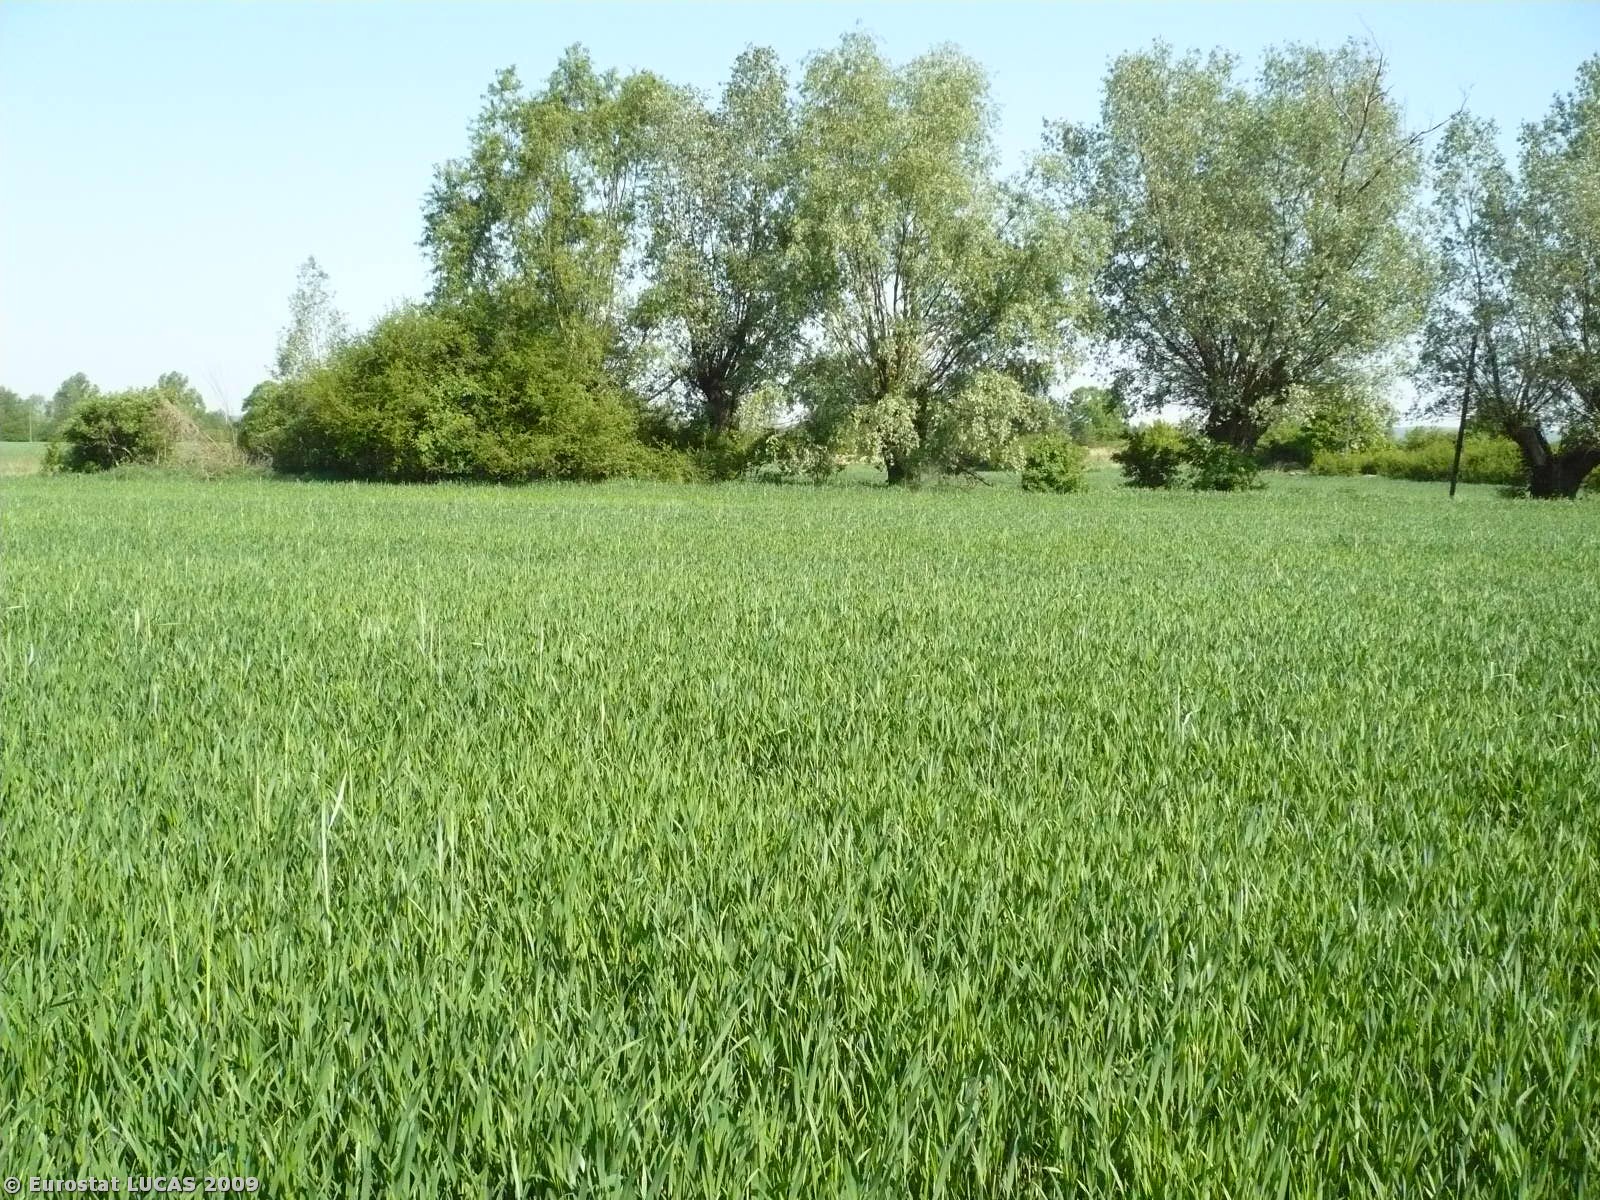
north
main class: Cropland
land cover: Common wheat
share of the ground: > 75 %
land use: Agriculture (excluding fallow land and kitchen gardens)
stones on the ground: < 10 %
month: May
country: PL
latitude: 52.0077
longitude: 15.6717
